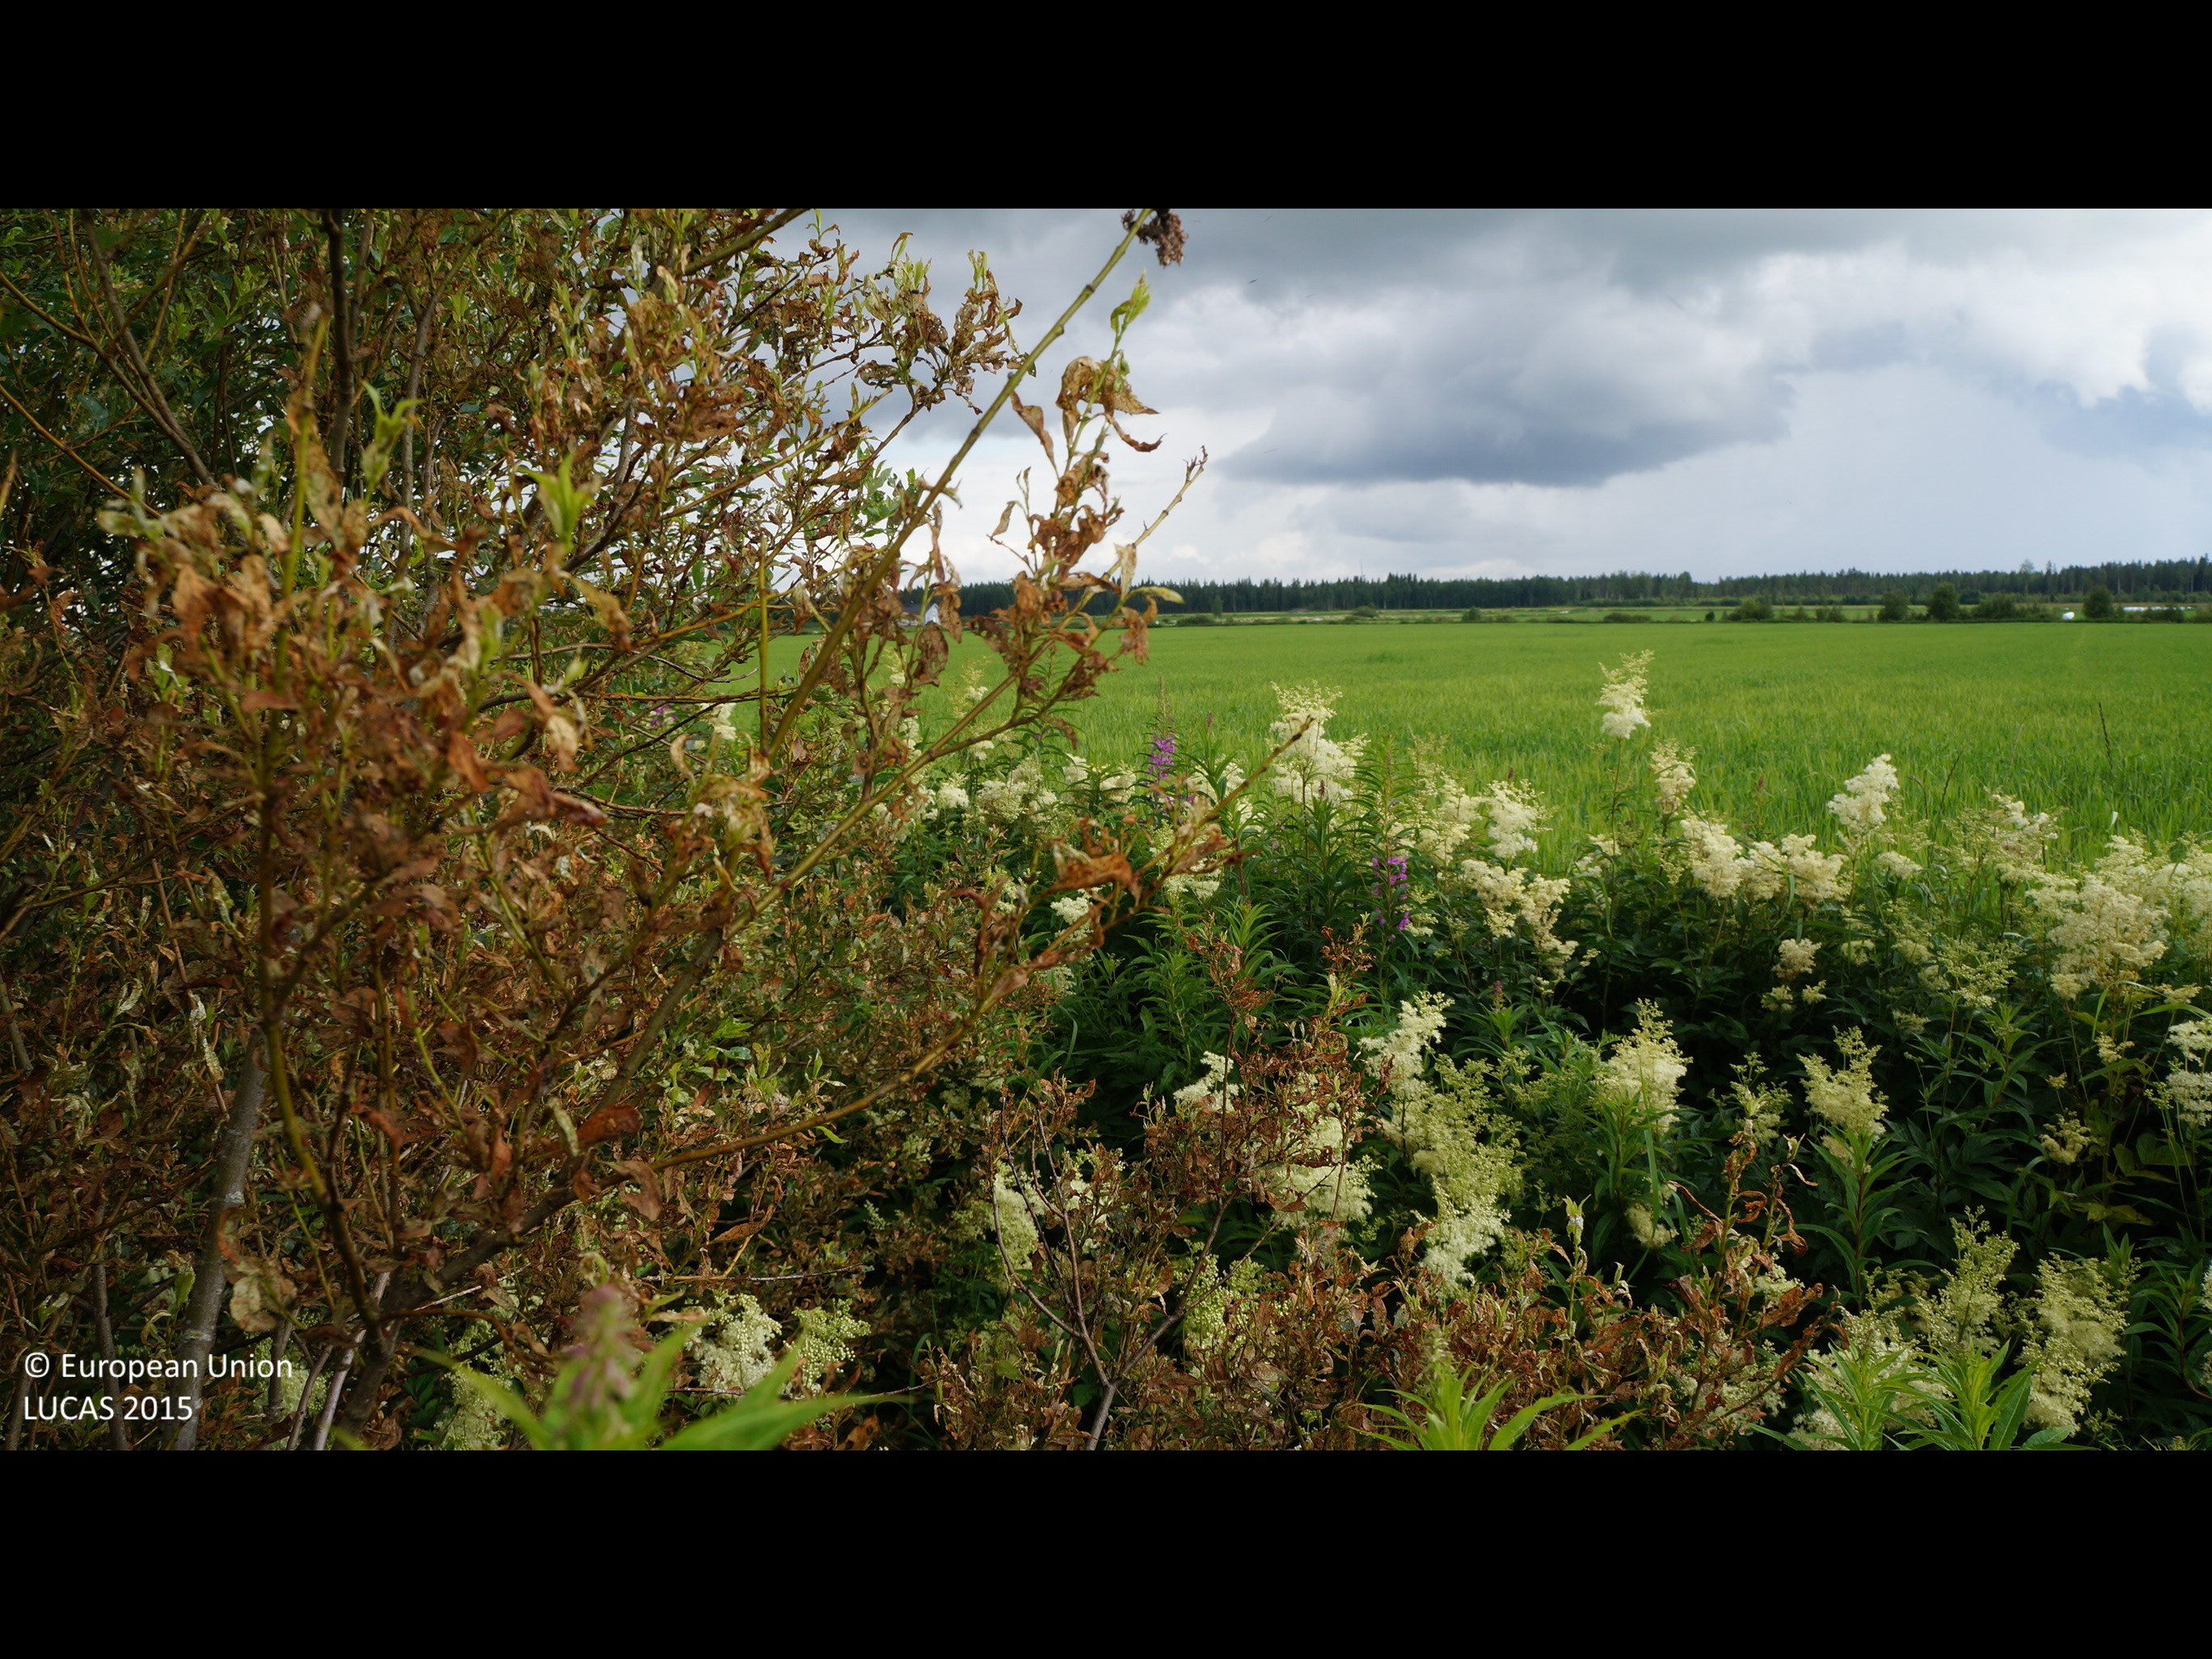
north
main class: Cropland
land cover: Barley
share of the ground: > 75 %
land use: Agriculture (excluding fallow land and kitchen gardens)
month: July
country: FI
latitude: 63.9268
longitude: 24.5344
